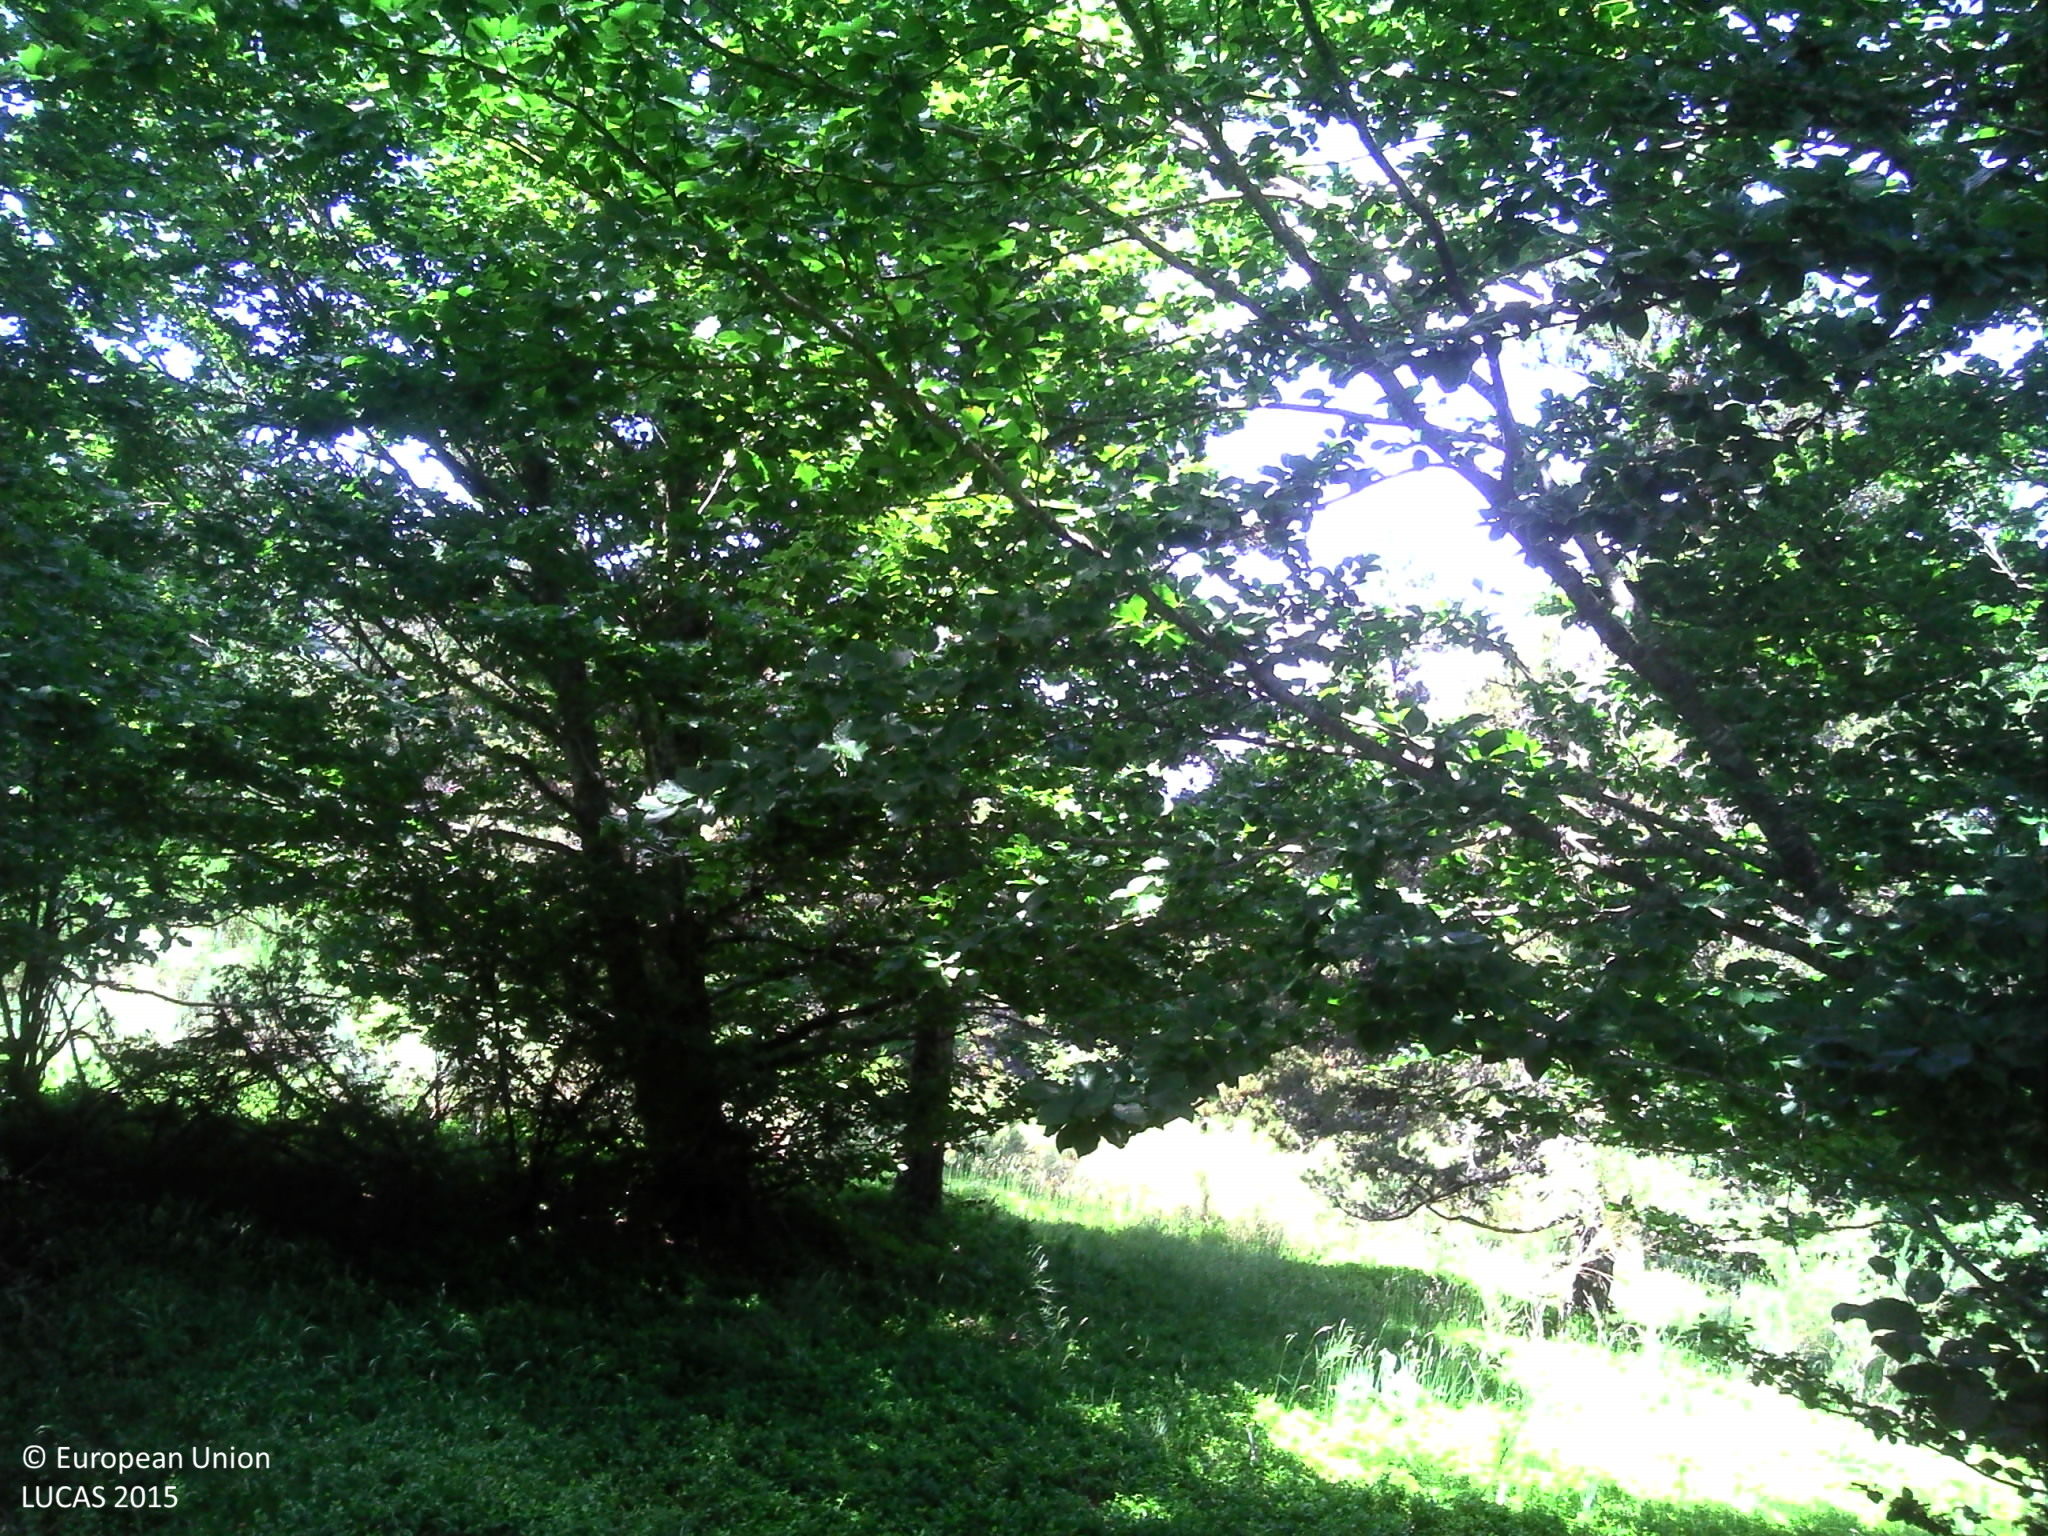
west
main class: Woodland
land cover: Pine dominated mixed woodland
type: mountainous beech forest
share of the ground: 50 - 75 %
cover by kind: herbaceous plants 40 %, broadleaved forest trees 35 %, coniferous forest trees 25 %
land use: Forestry
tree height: > 5 m
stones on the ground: 10 - 25 %
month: June
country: FR
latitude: 44.5788
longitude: 3.4686
